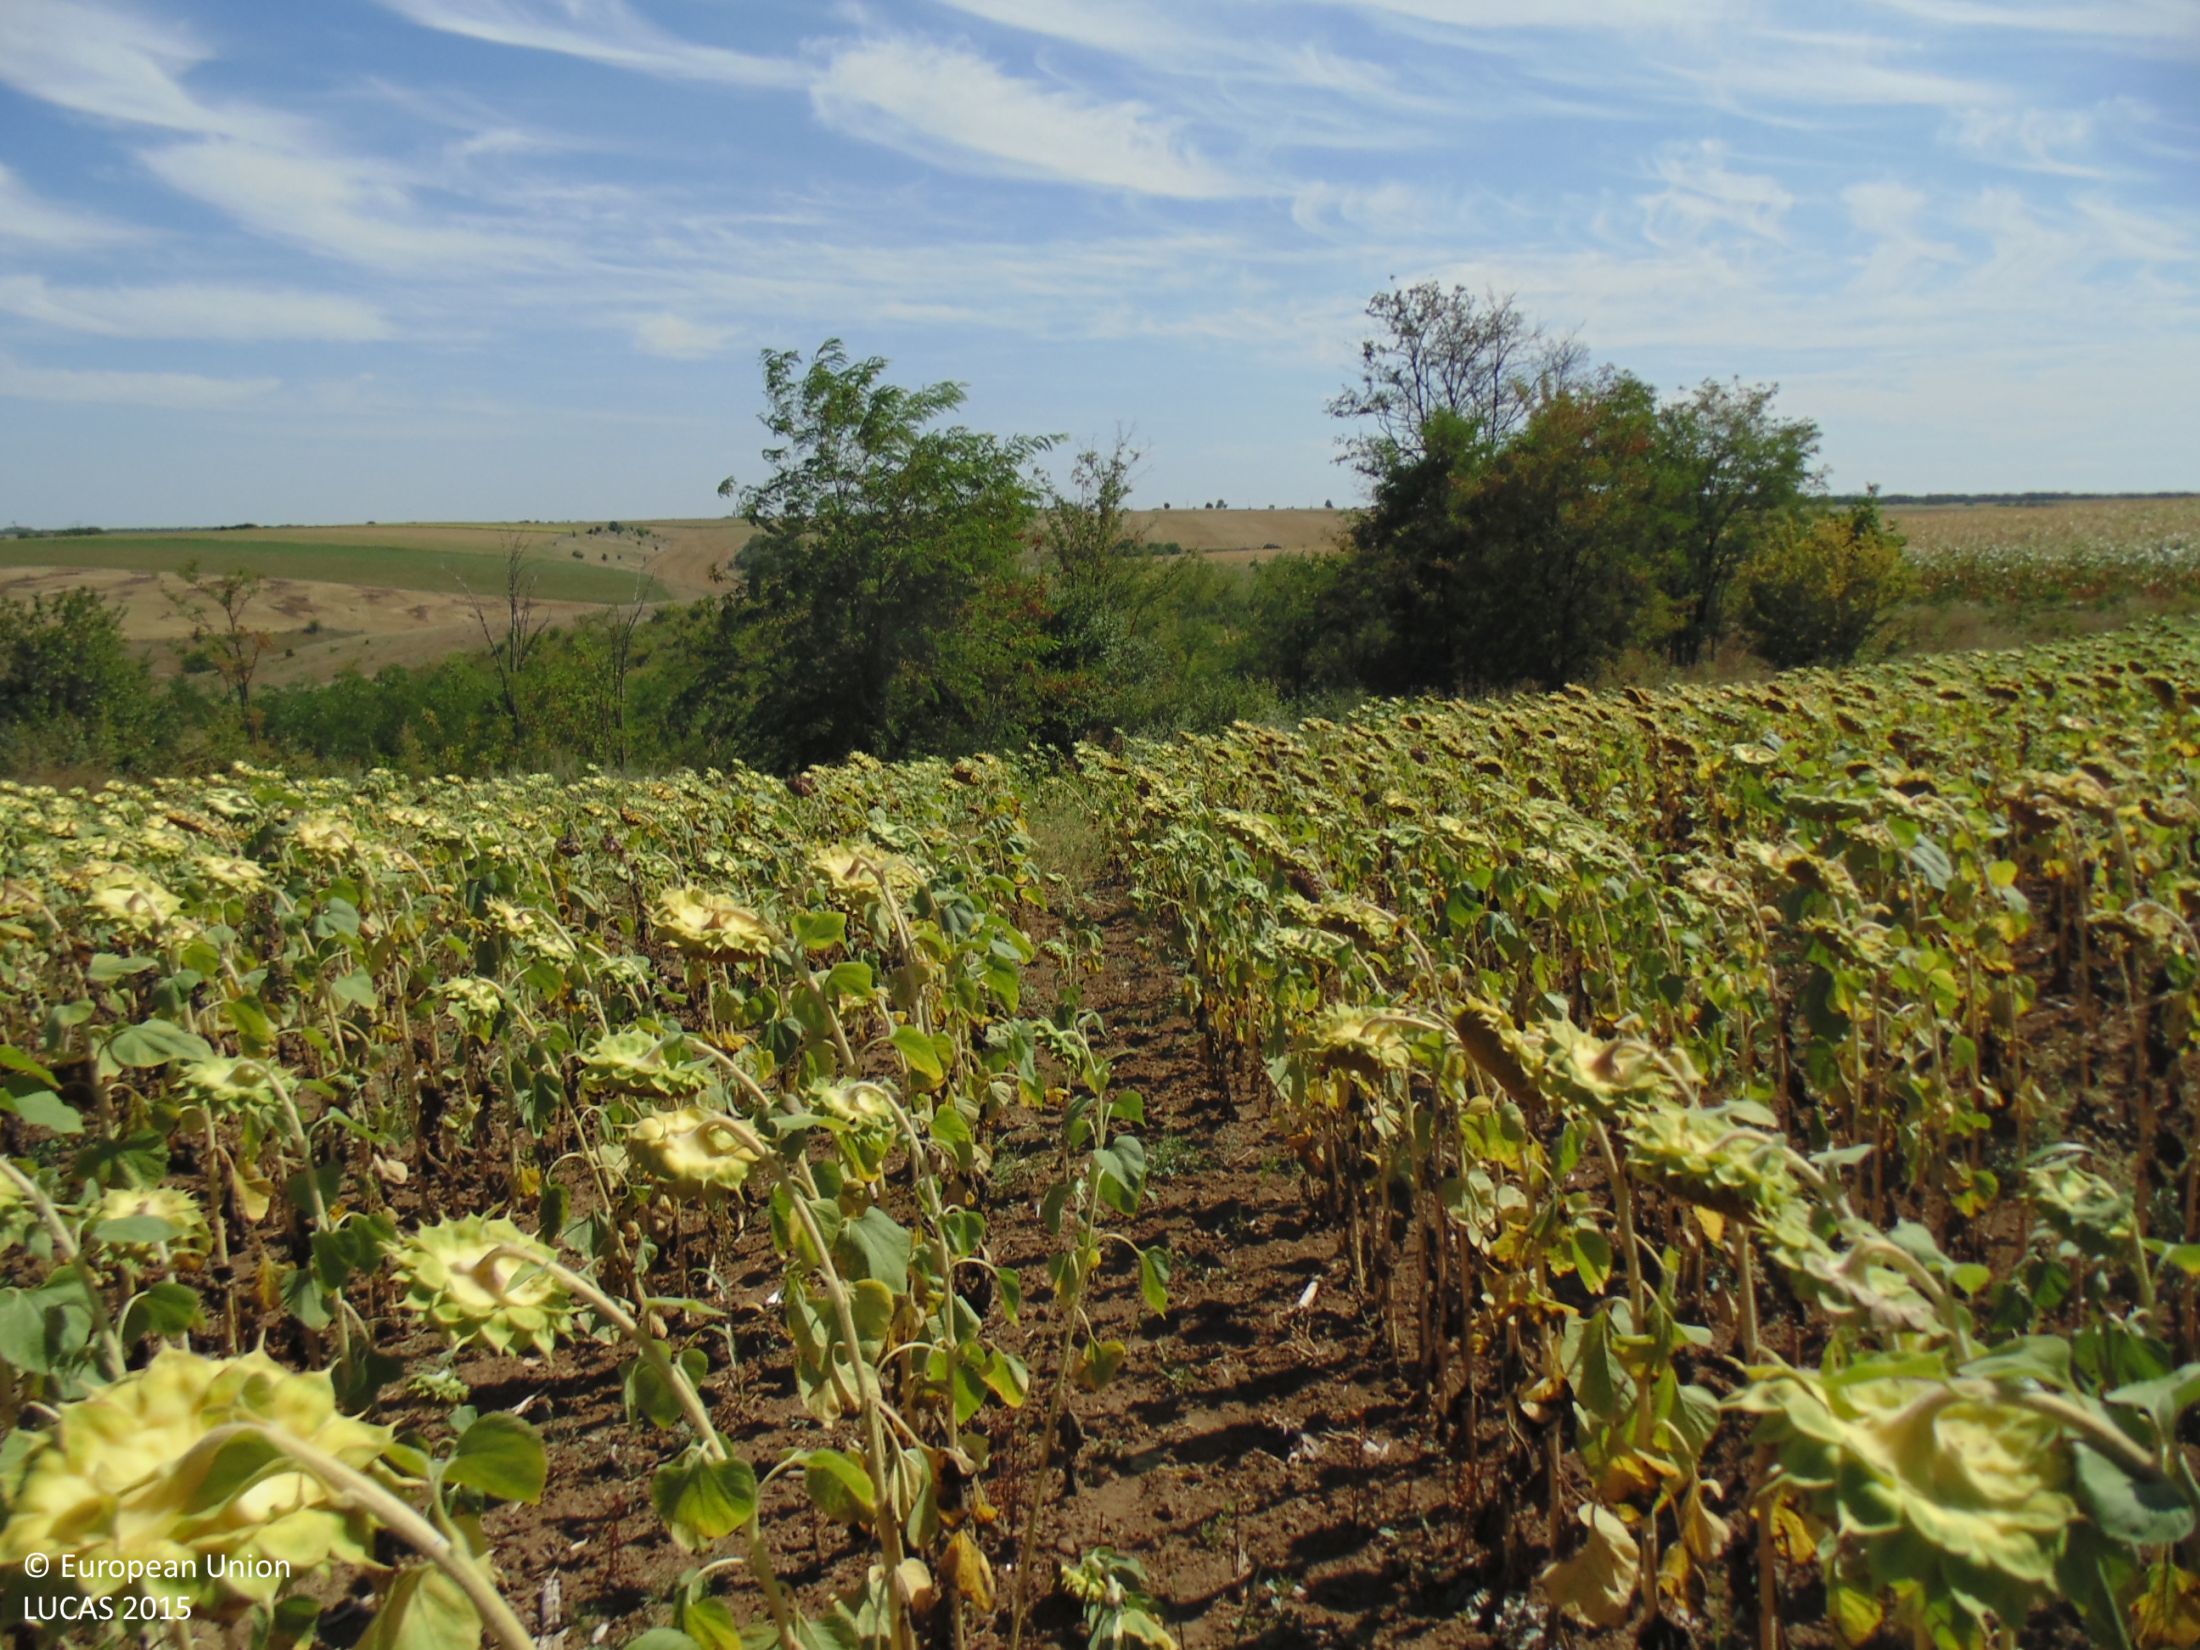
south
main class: Cropland
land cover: Sunflower
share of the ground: > 75 %
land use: Agriculture (excluding fallow land and kitchen gardens)
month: August
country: BG
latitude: 43.8433
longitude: 27.7167
